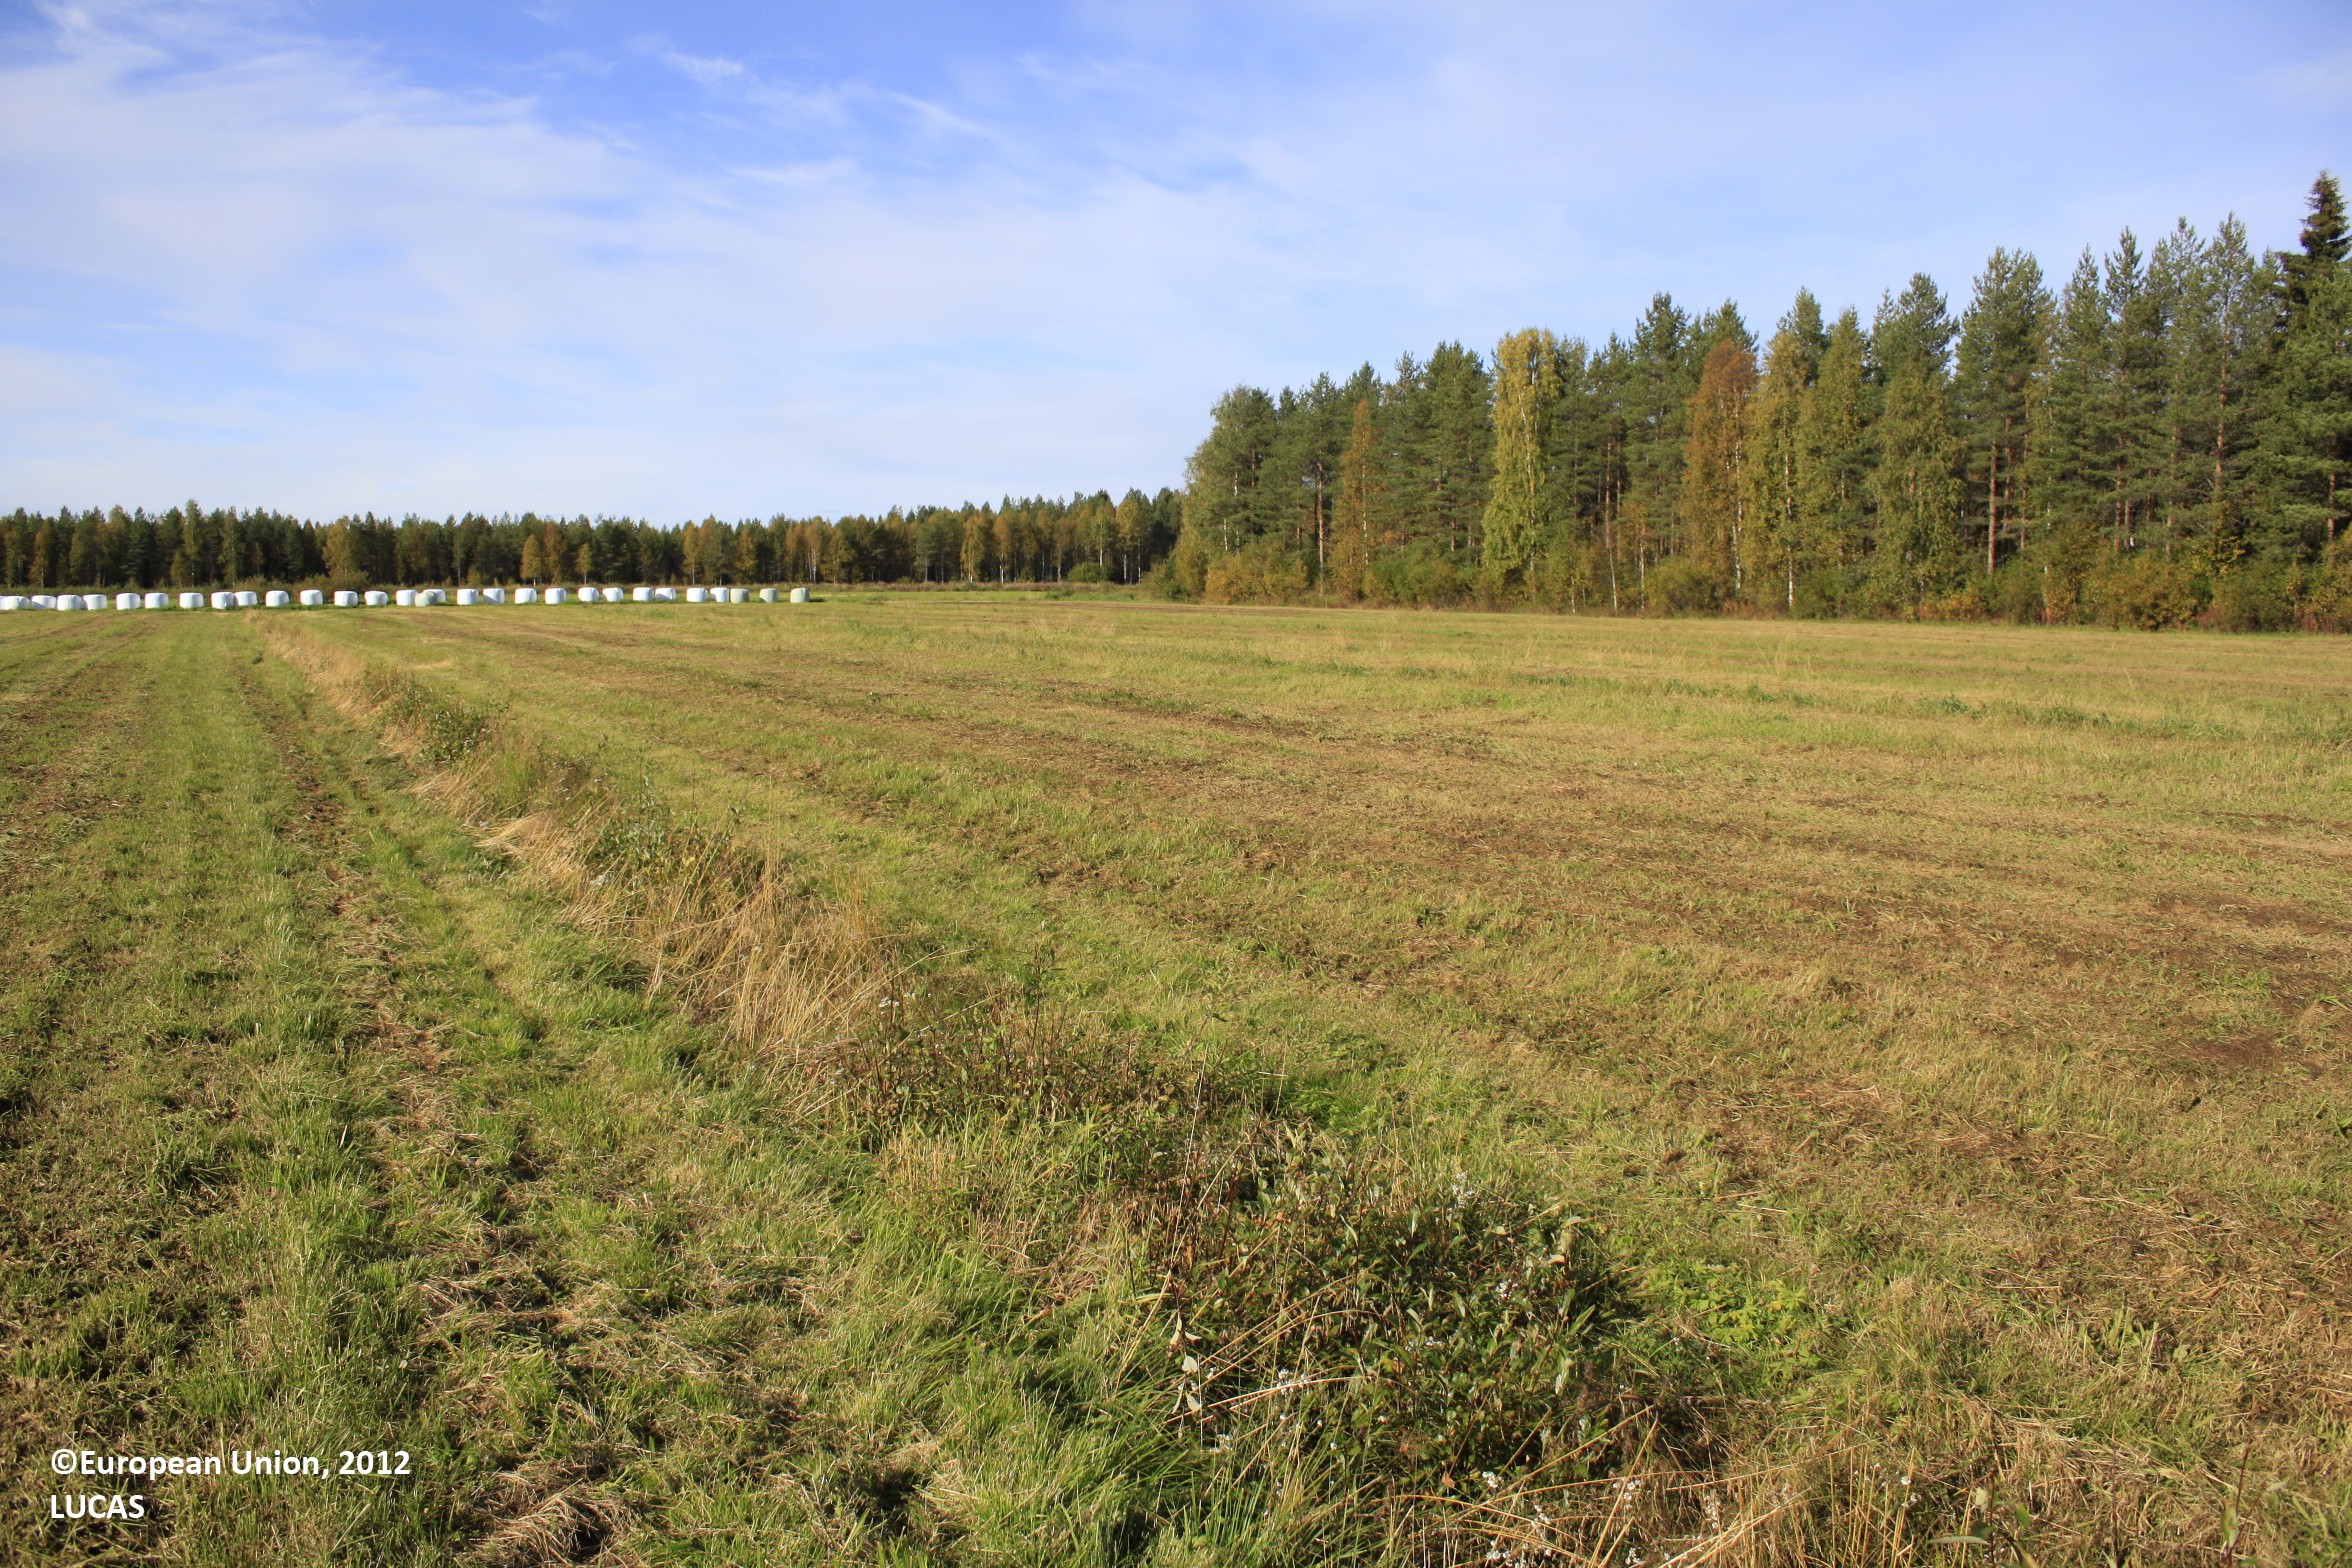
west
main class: Grassland
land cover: Grassland without tree/shrub cover
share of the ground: > 75 %
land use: Agriculture (excluding fallow land and kitchen gardens)
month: September
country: FI
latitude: 65.5888
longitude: 27.1848
